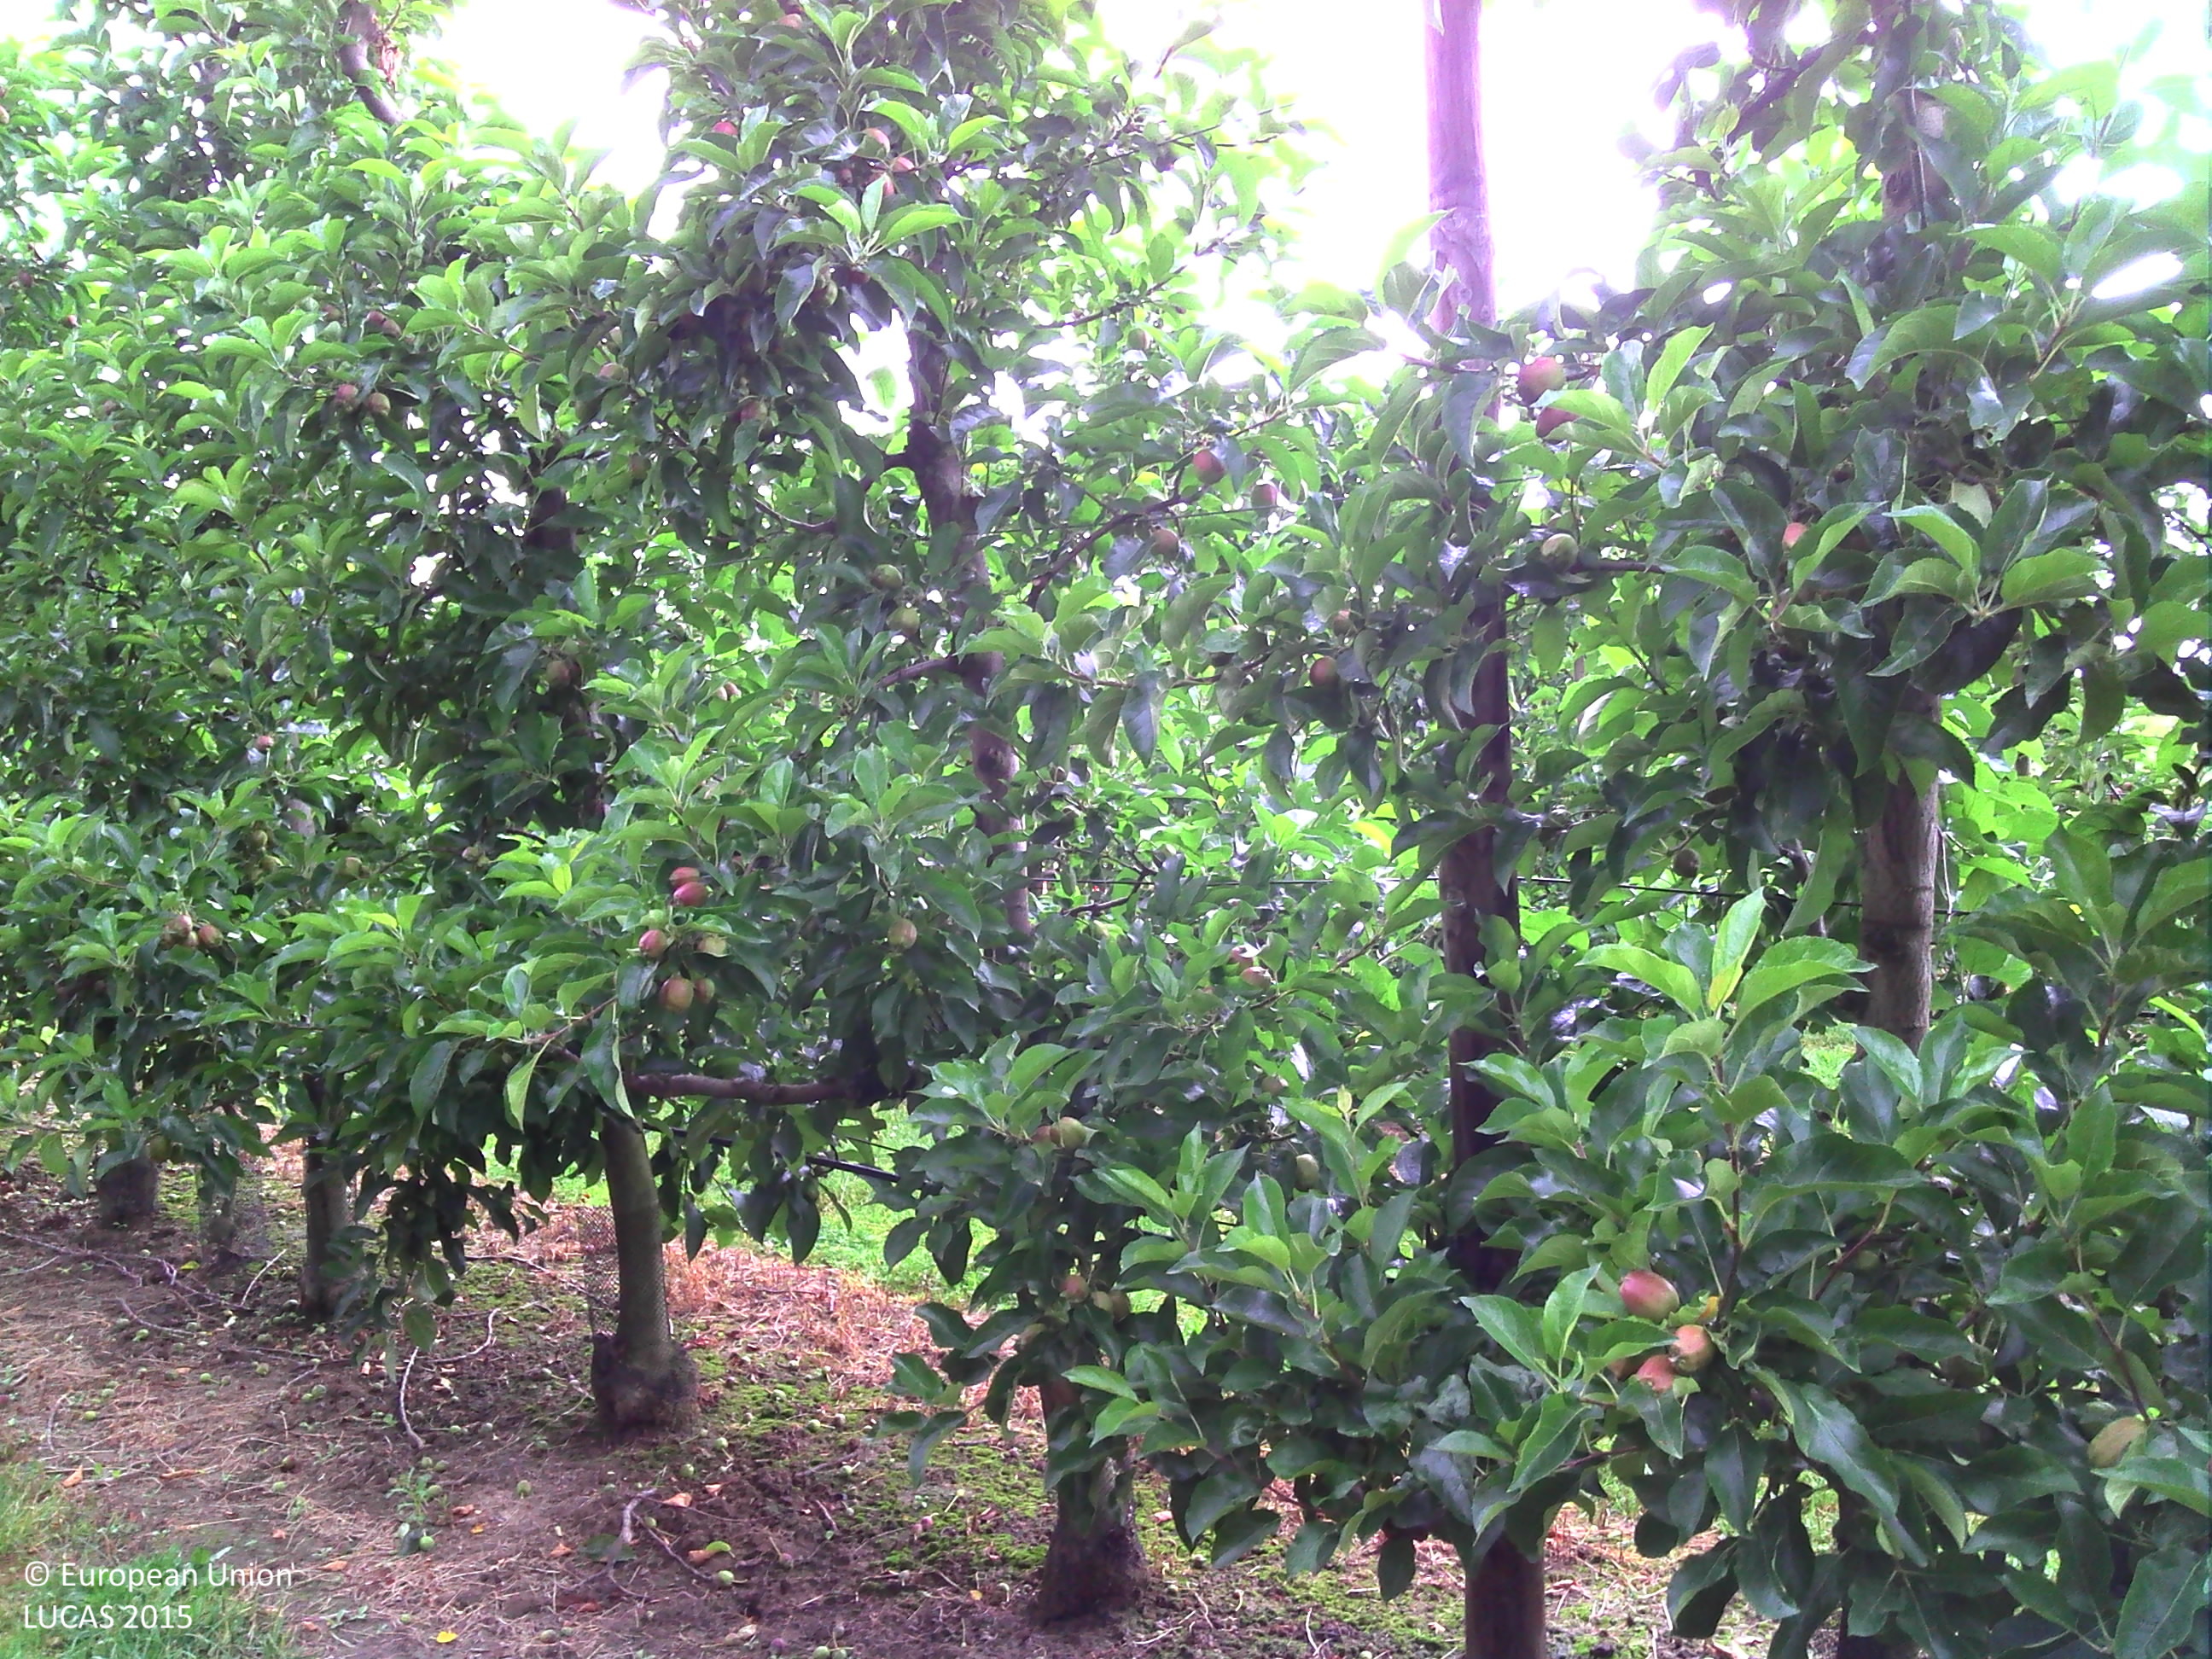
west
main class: Cropland
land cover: Apple fruit
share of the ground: 50 - 75 %
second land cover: Grassland without tree/shrub cover
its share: 25 - 50 %
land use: Agriculture (excluding fallow land and kitchen gardens)
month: June
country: BE
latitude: 50.8964
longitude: 5.2631
